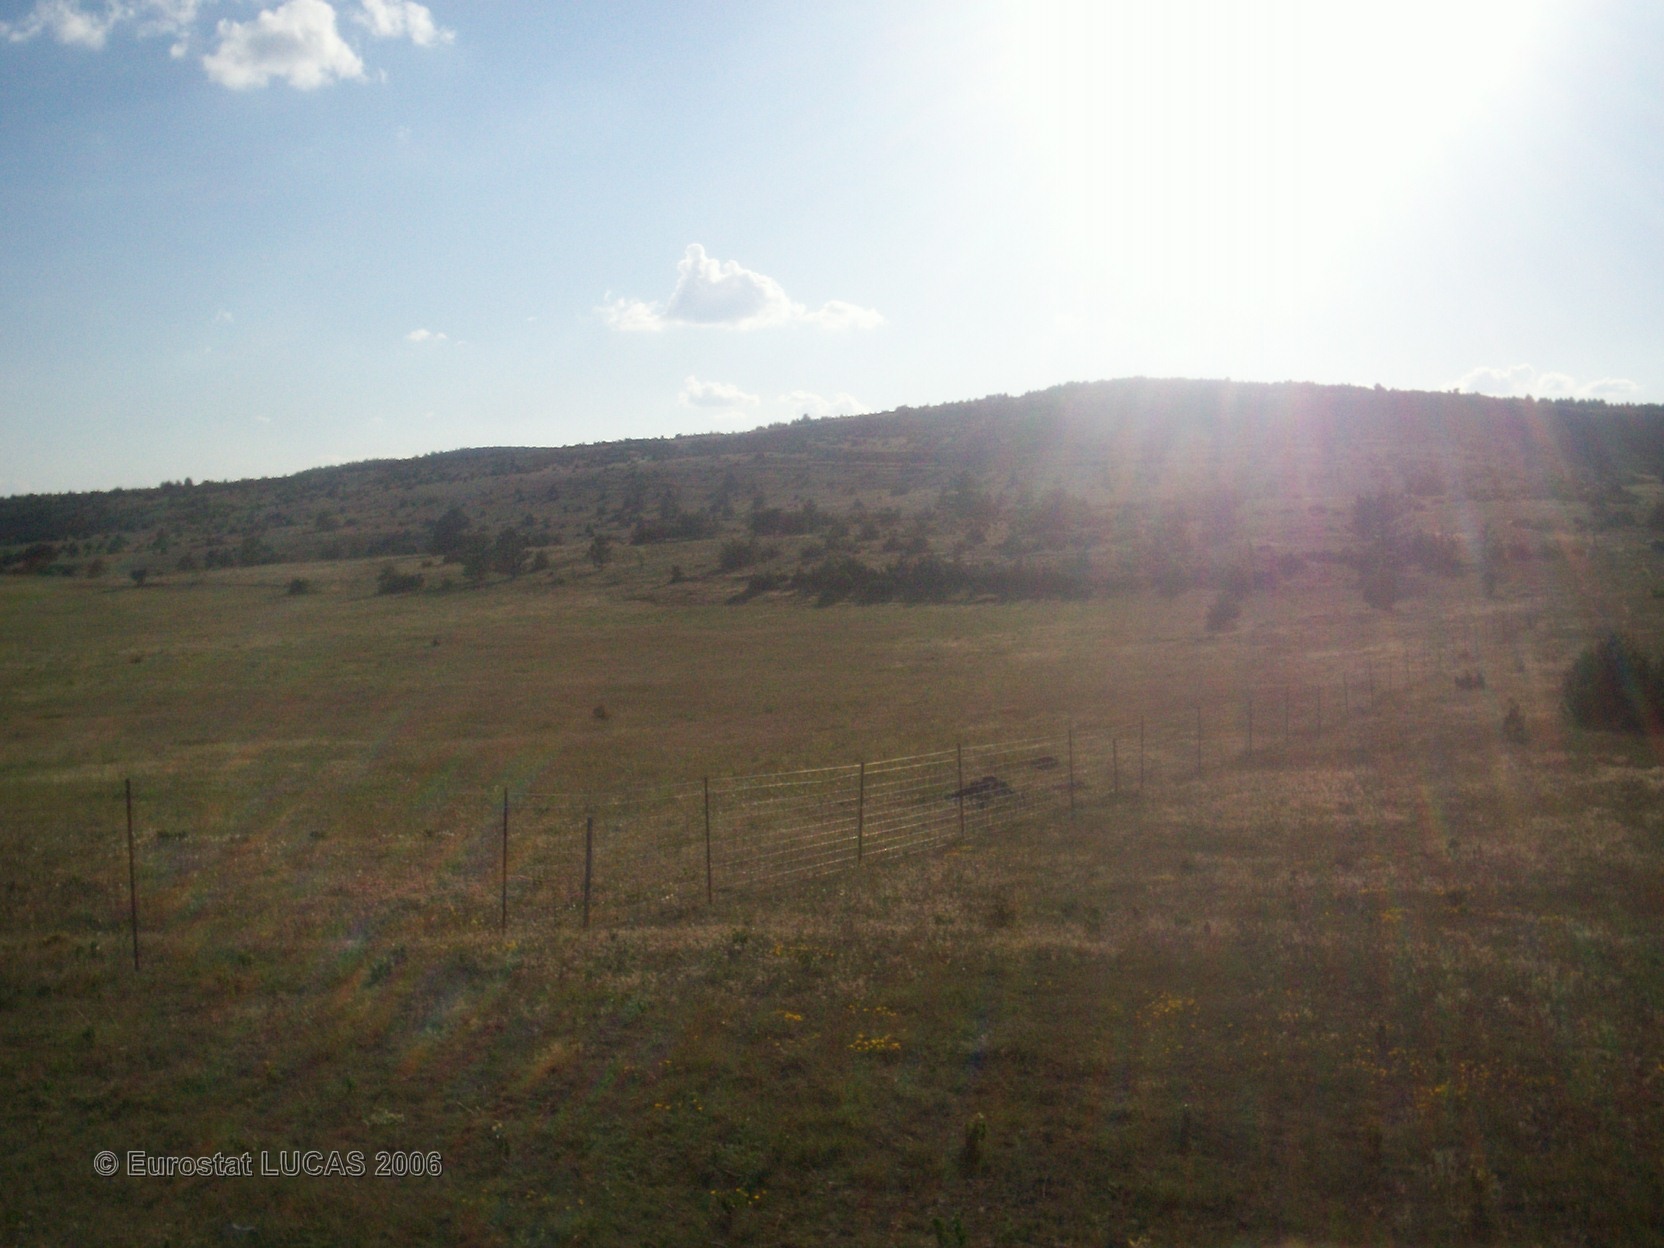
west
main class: Grassland
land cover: Grassland without tree/shrub cover
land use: Agriculture (excluding fallow land and kitchen gardens)
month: June
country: FR
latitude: 44.3243
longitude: 3.4477
